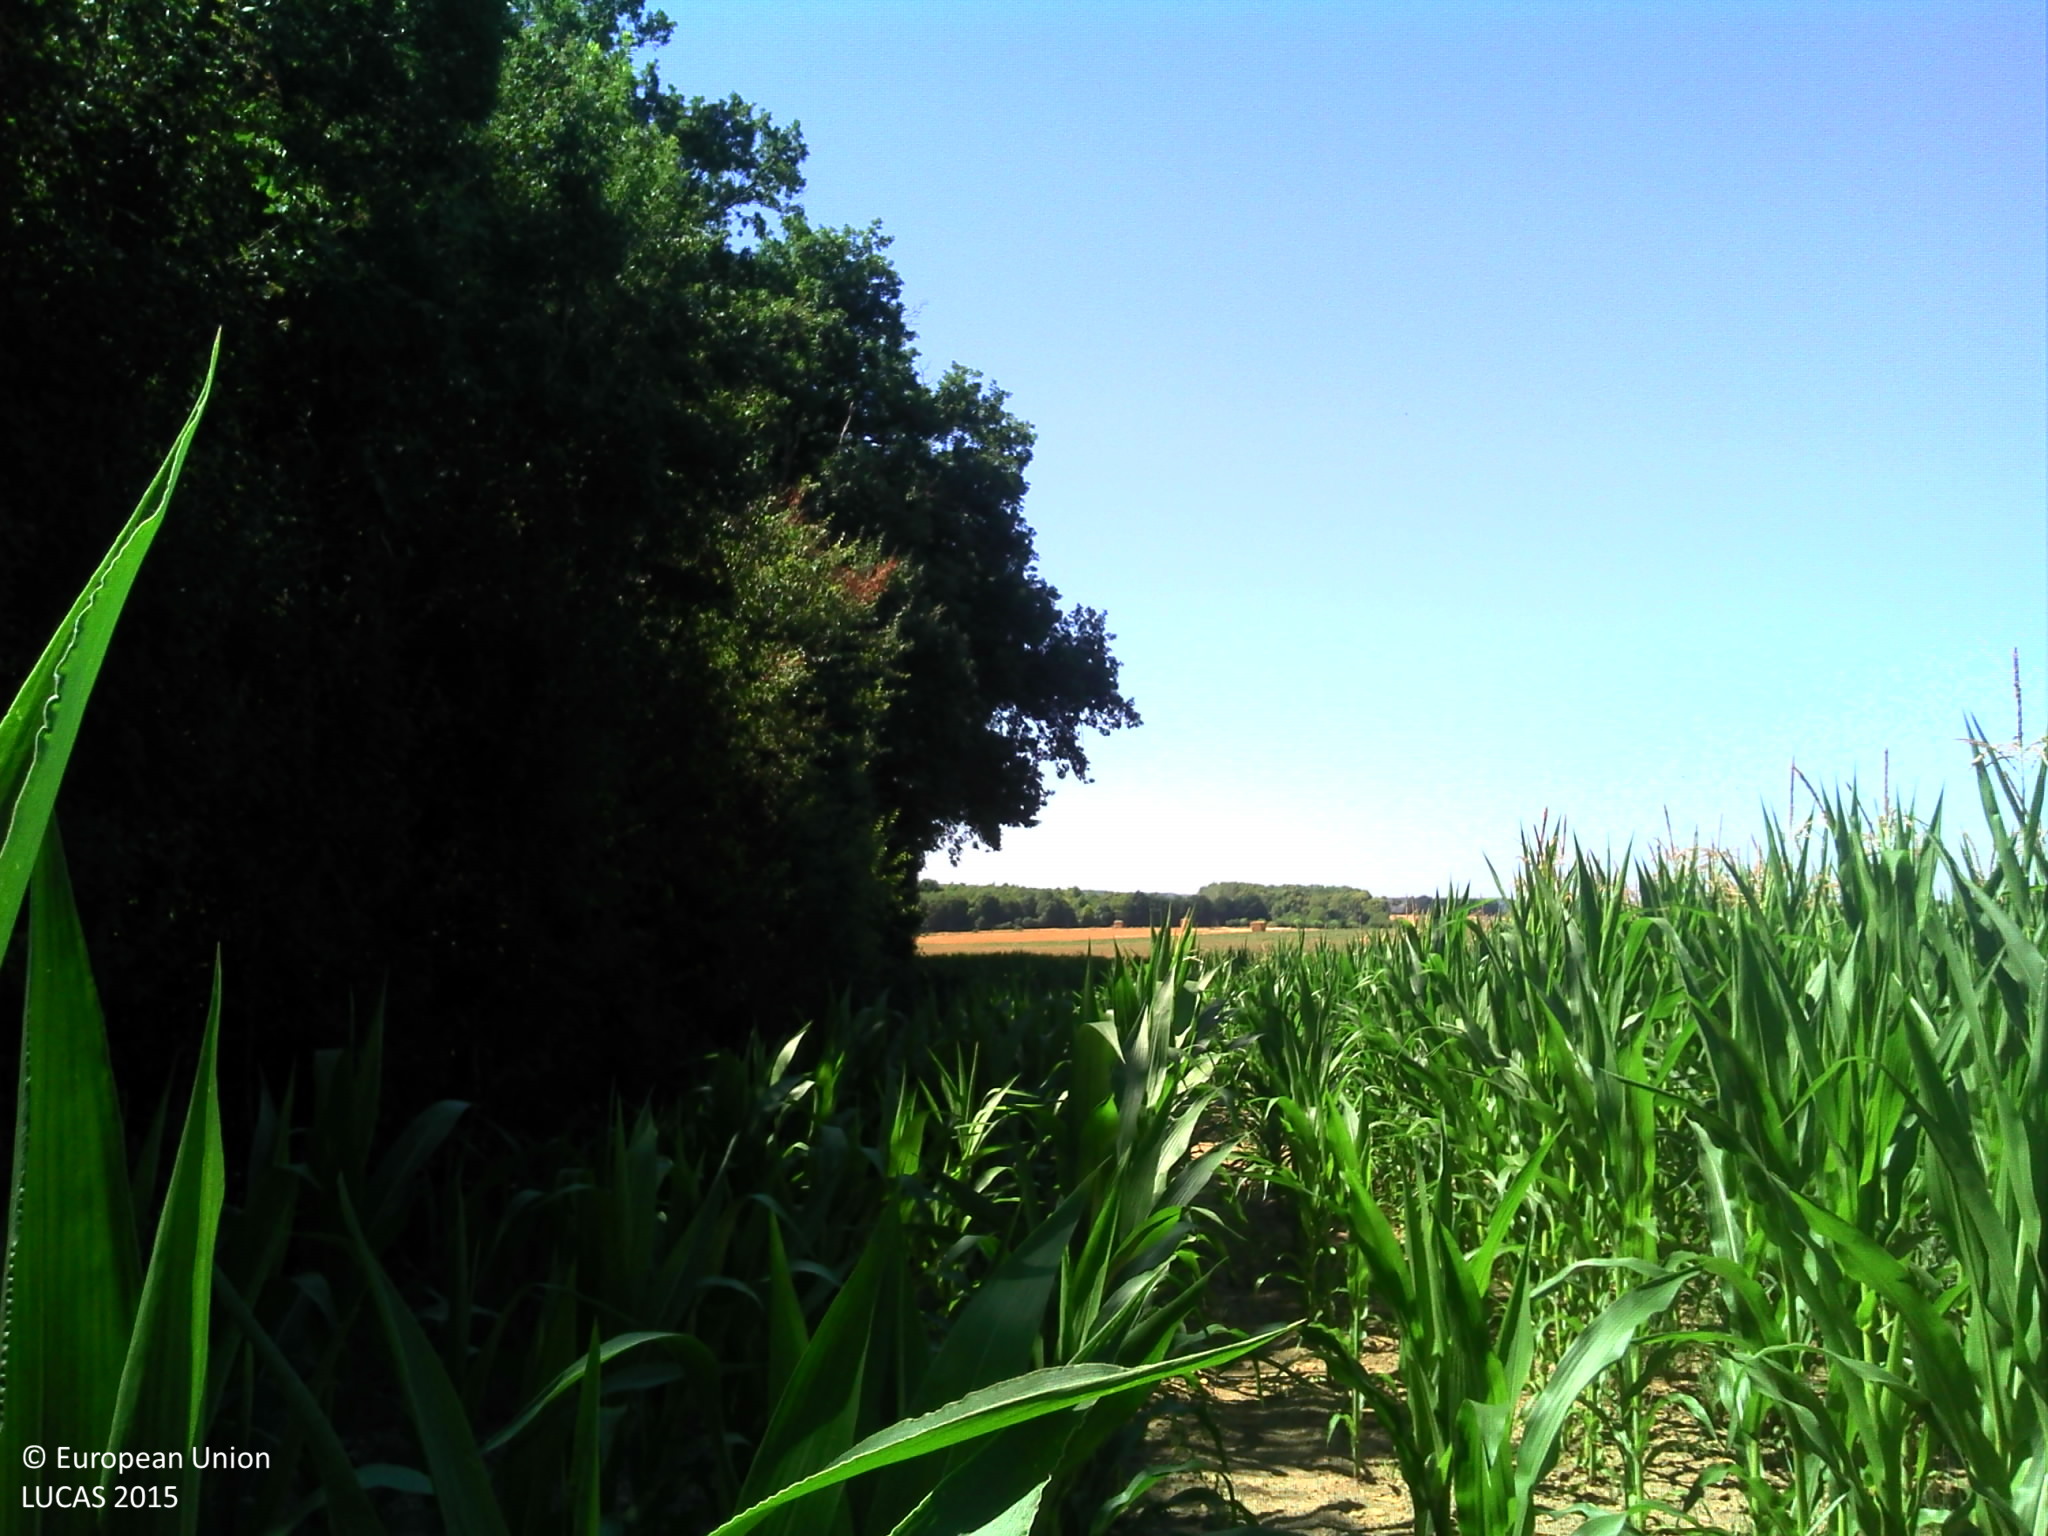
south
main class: Cropland
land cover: Maize
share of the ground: > 75 %
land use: Agriculture (excluding fallow land and kitchen gardens)
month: July
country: FR
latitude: 47.5831
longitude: 0.3639
